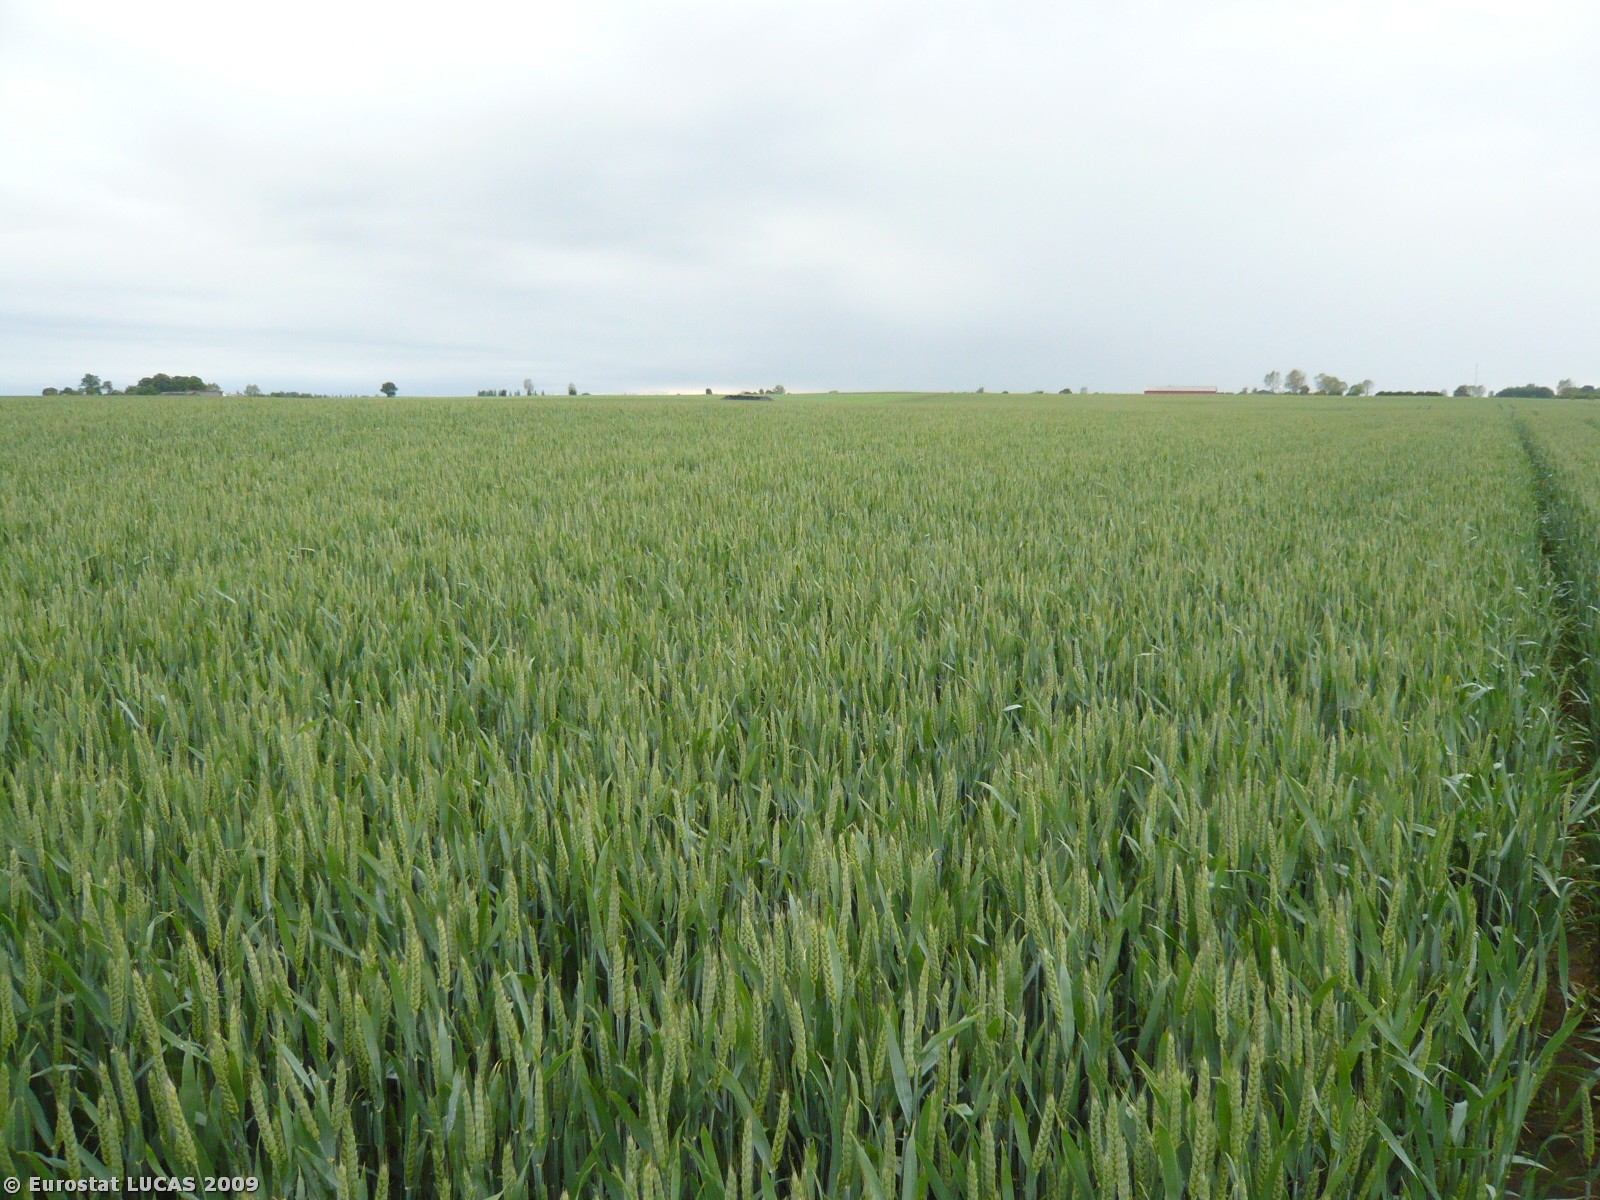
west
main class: Cropland
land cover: Common wheat
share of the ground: > 75 %
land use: Agriculture (excluding fallow land and kitchen gardens)
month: June
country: DK
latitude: 54.7512
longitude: 12.0341
